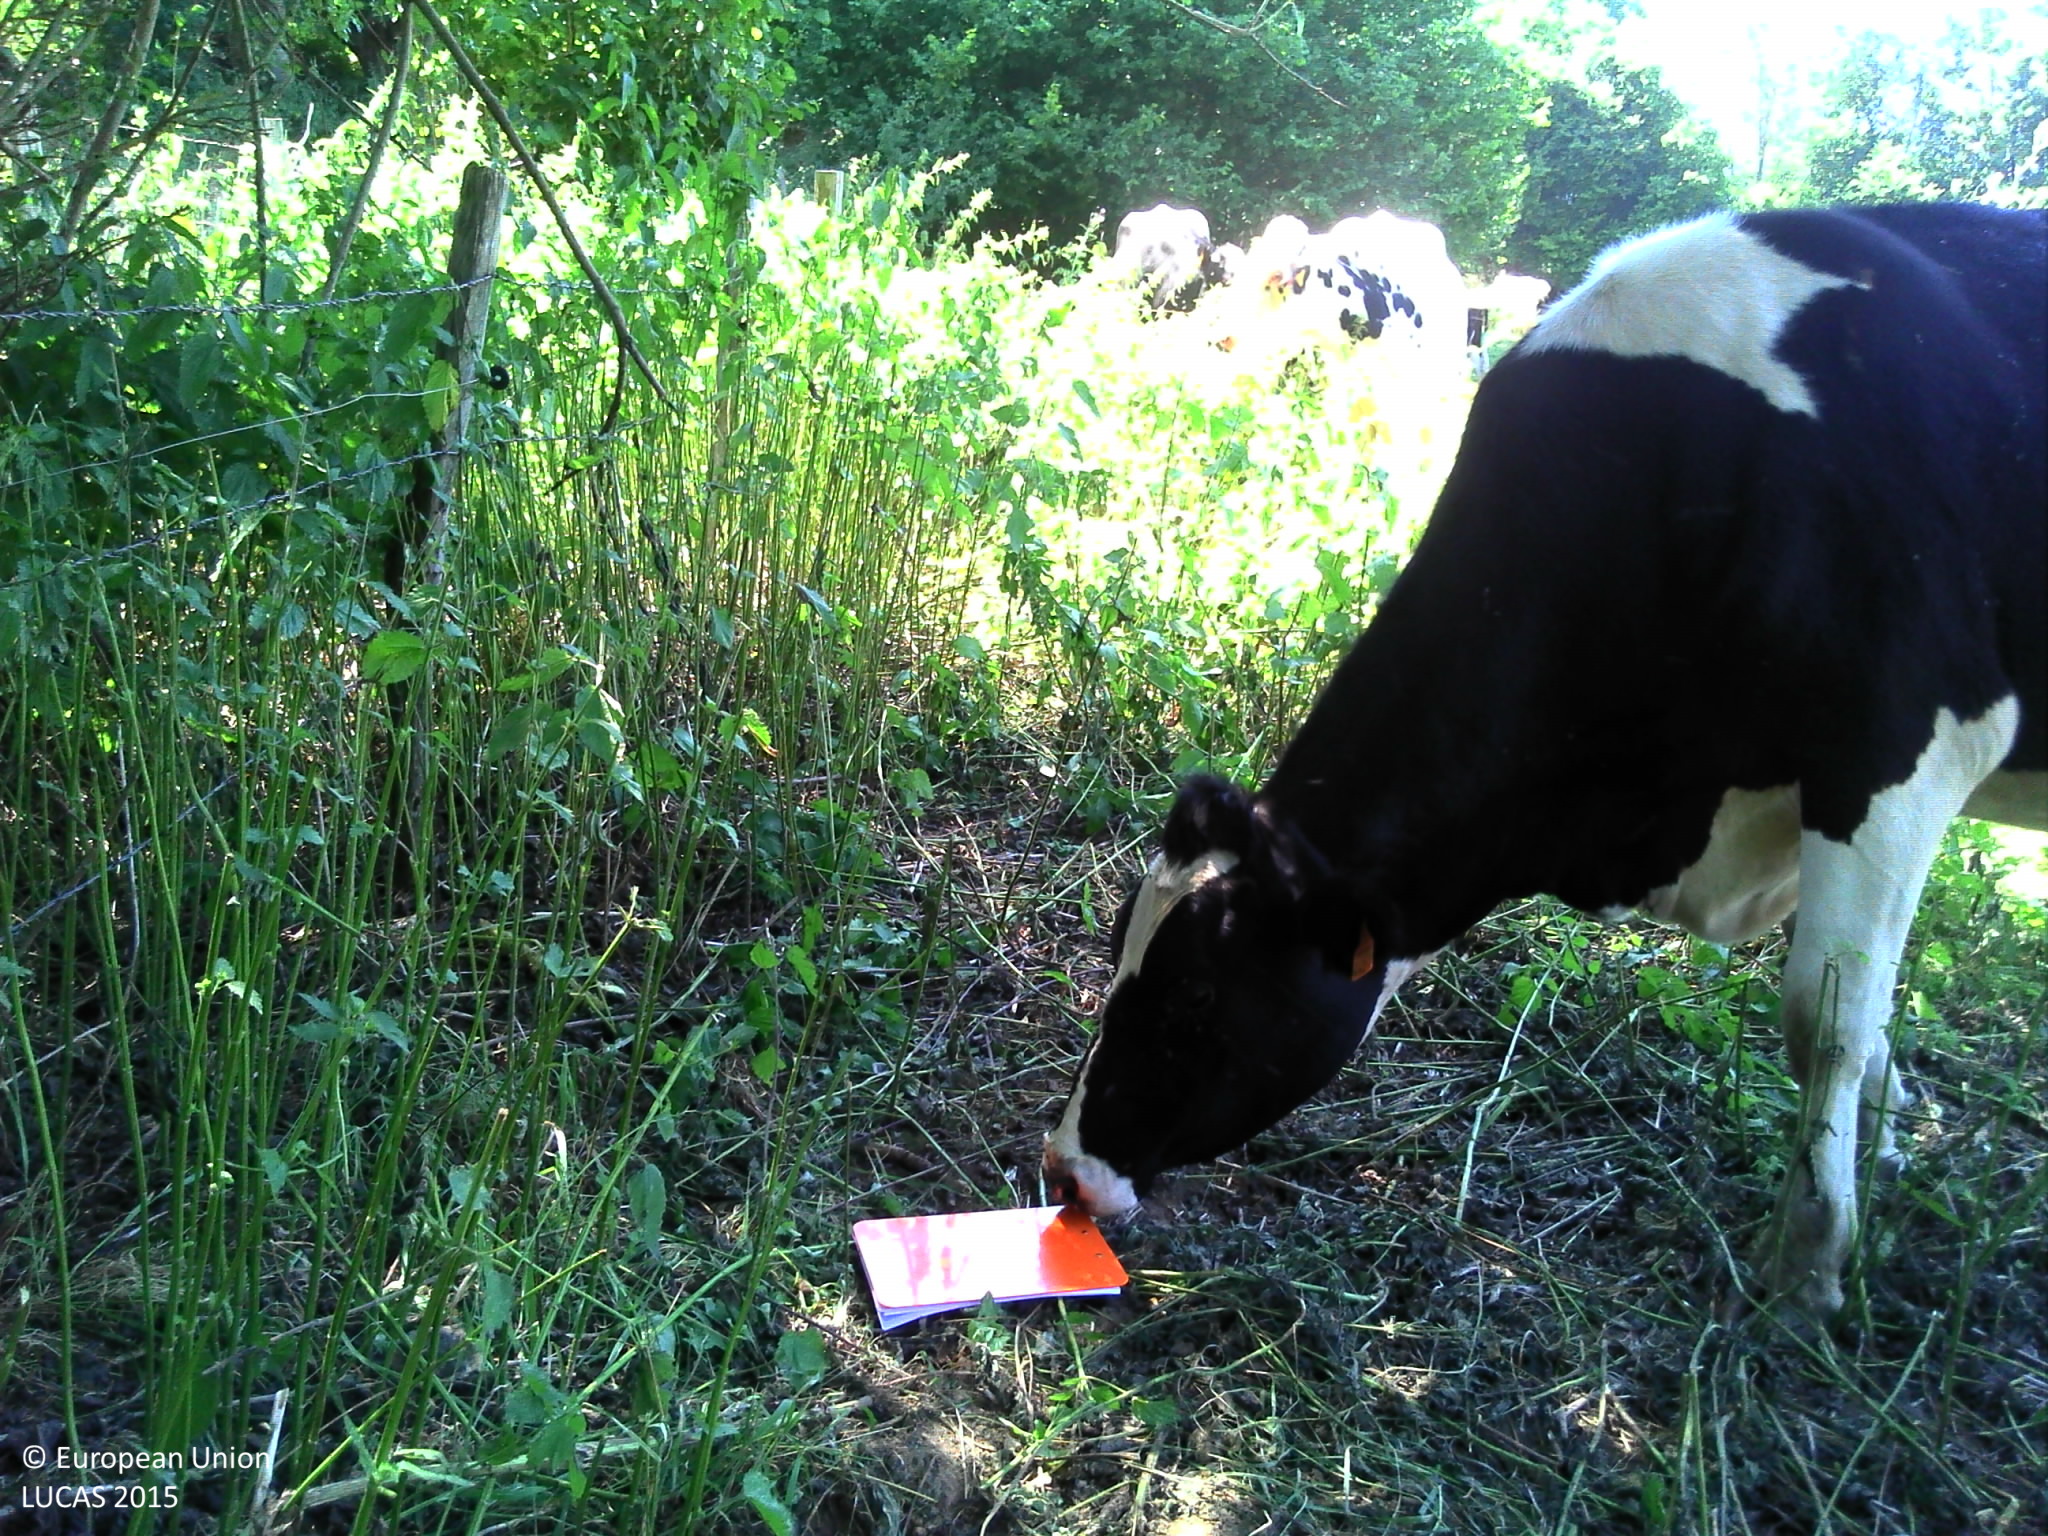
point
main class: Woodland
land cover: Broadleaved woodland
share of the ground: > 75 %
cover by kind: herbaceous plants 80 %, broadleaved forest trees 20 %
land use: Agriculture (excluding fallow land and kitchen gardens)
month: August
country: FR
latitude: 45.6794
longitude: 2.8739
